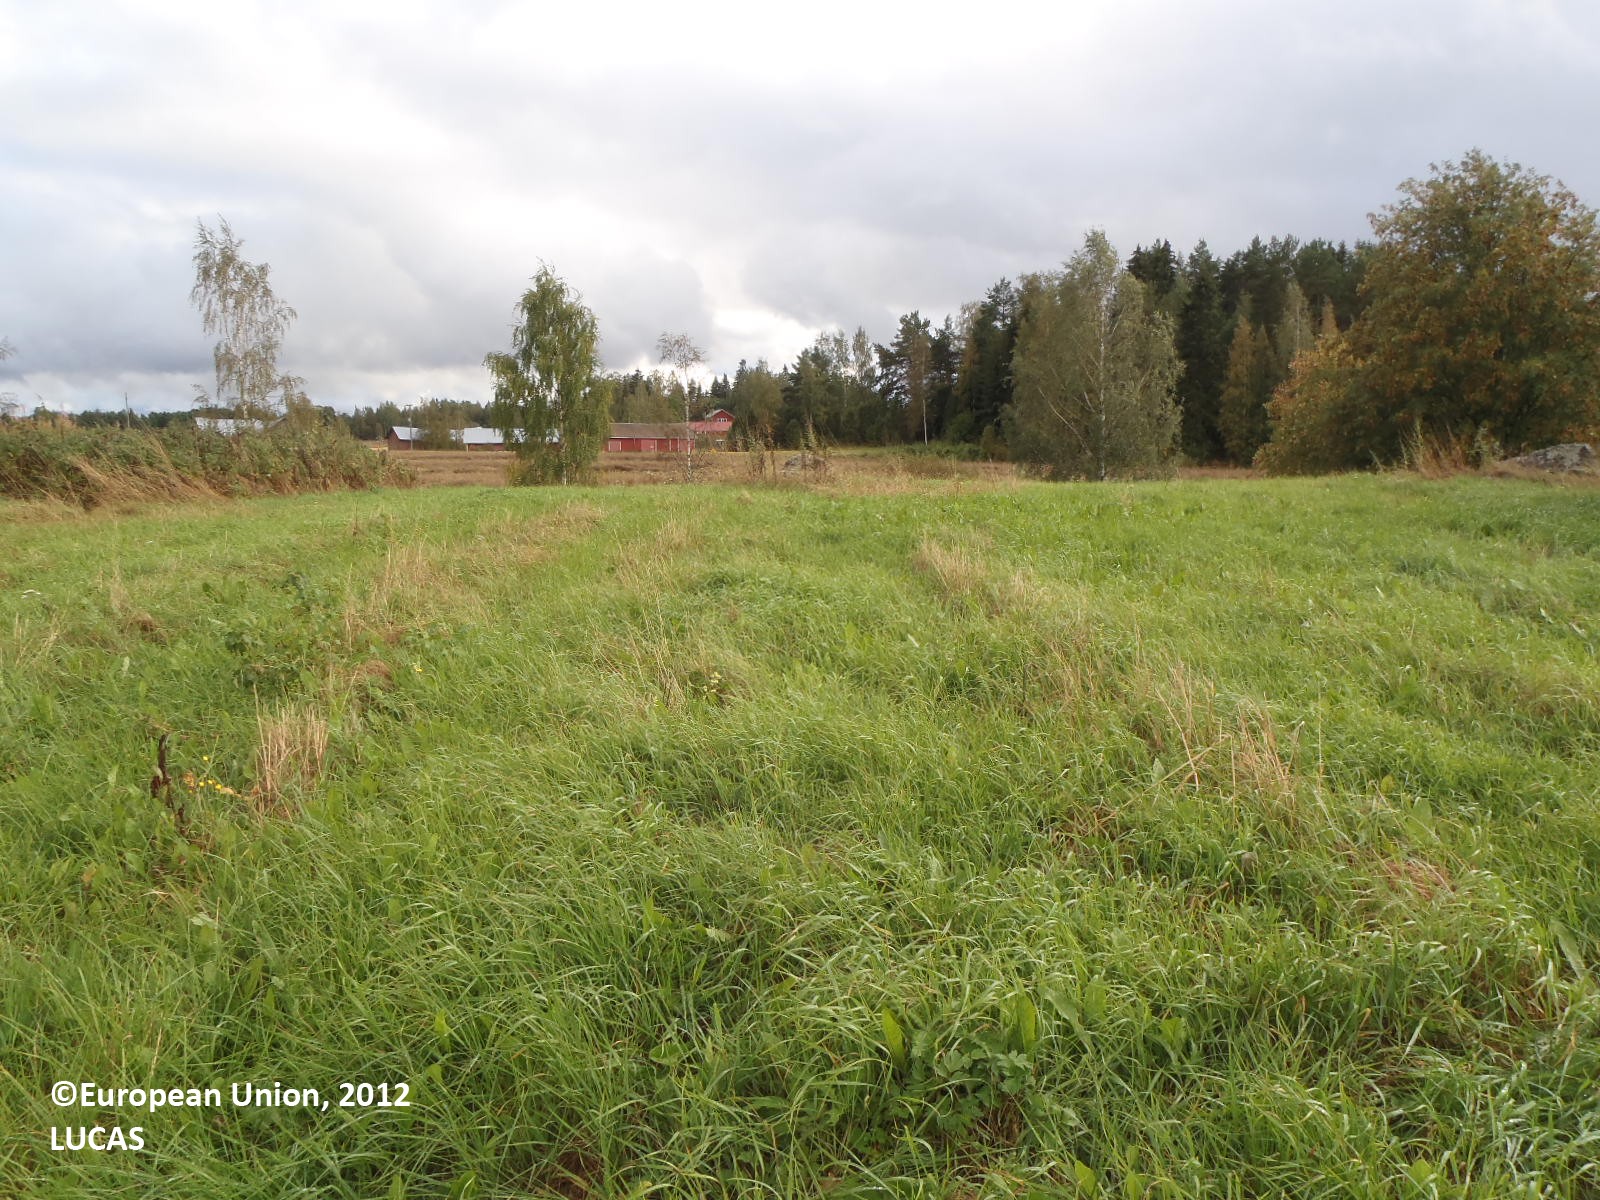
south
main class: Grassland
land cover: Grassland without tree/shrub cover
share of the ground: > 75 %
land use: Agriculture (excluding fallow land and kitchen gardens)
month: September
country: FI
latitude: 61.6113
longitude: 22.5255
